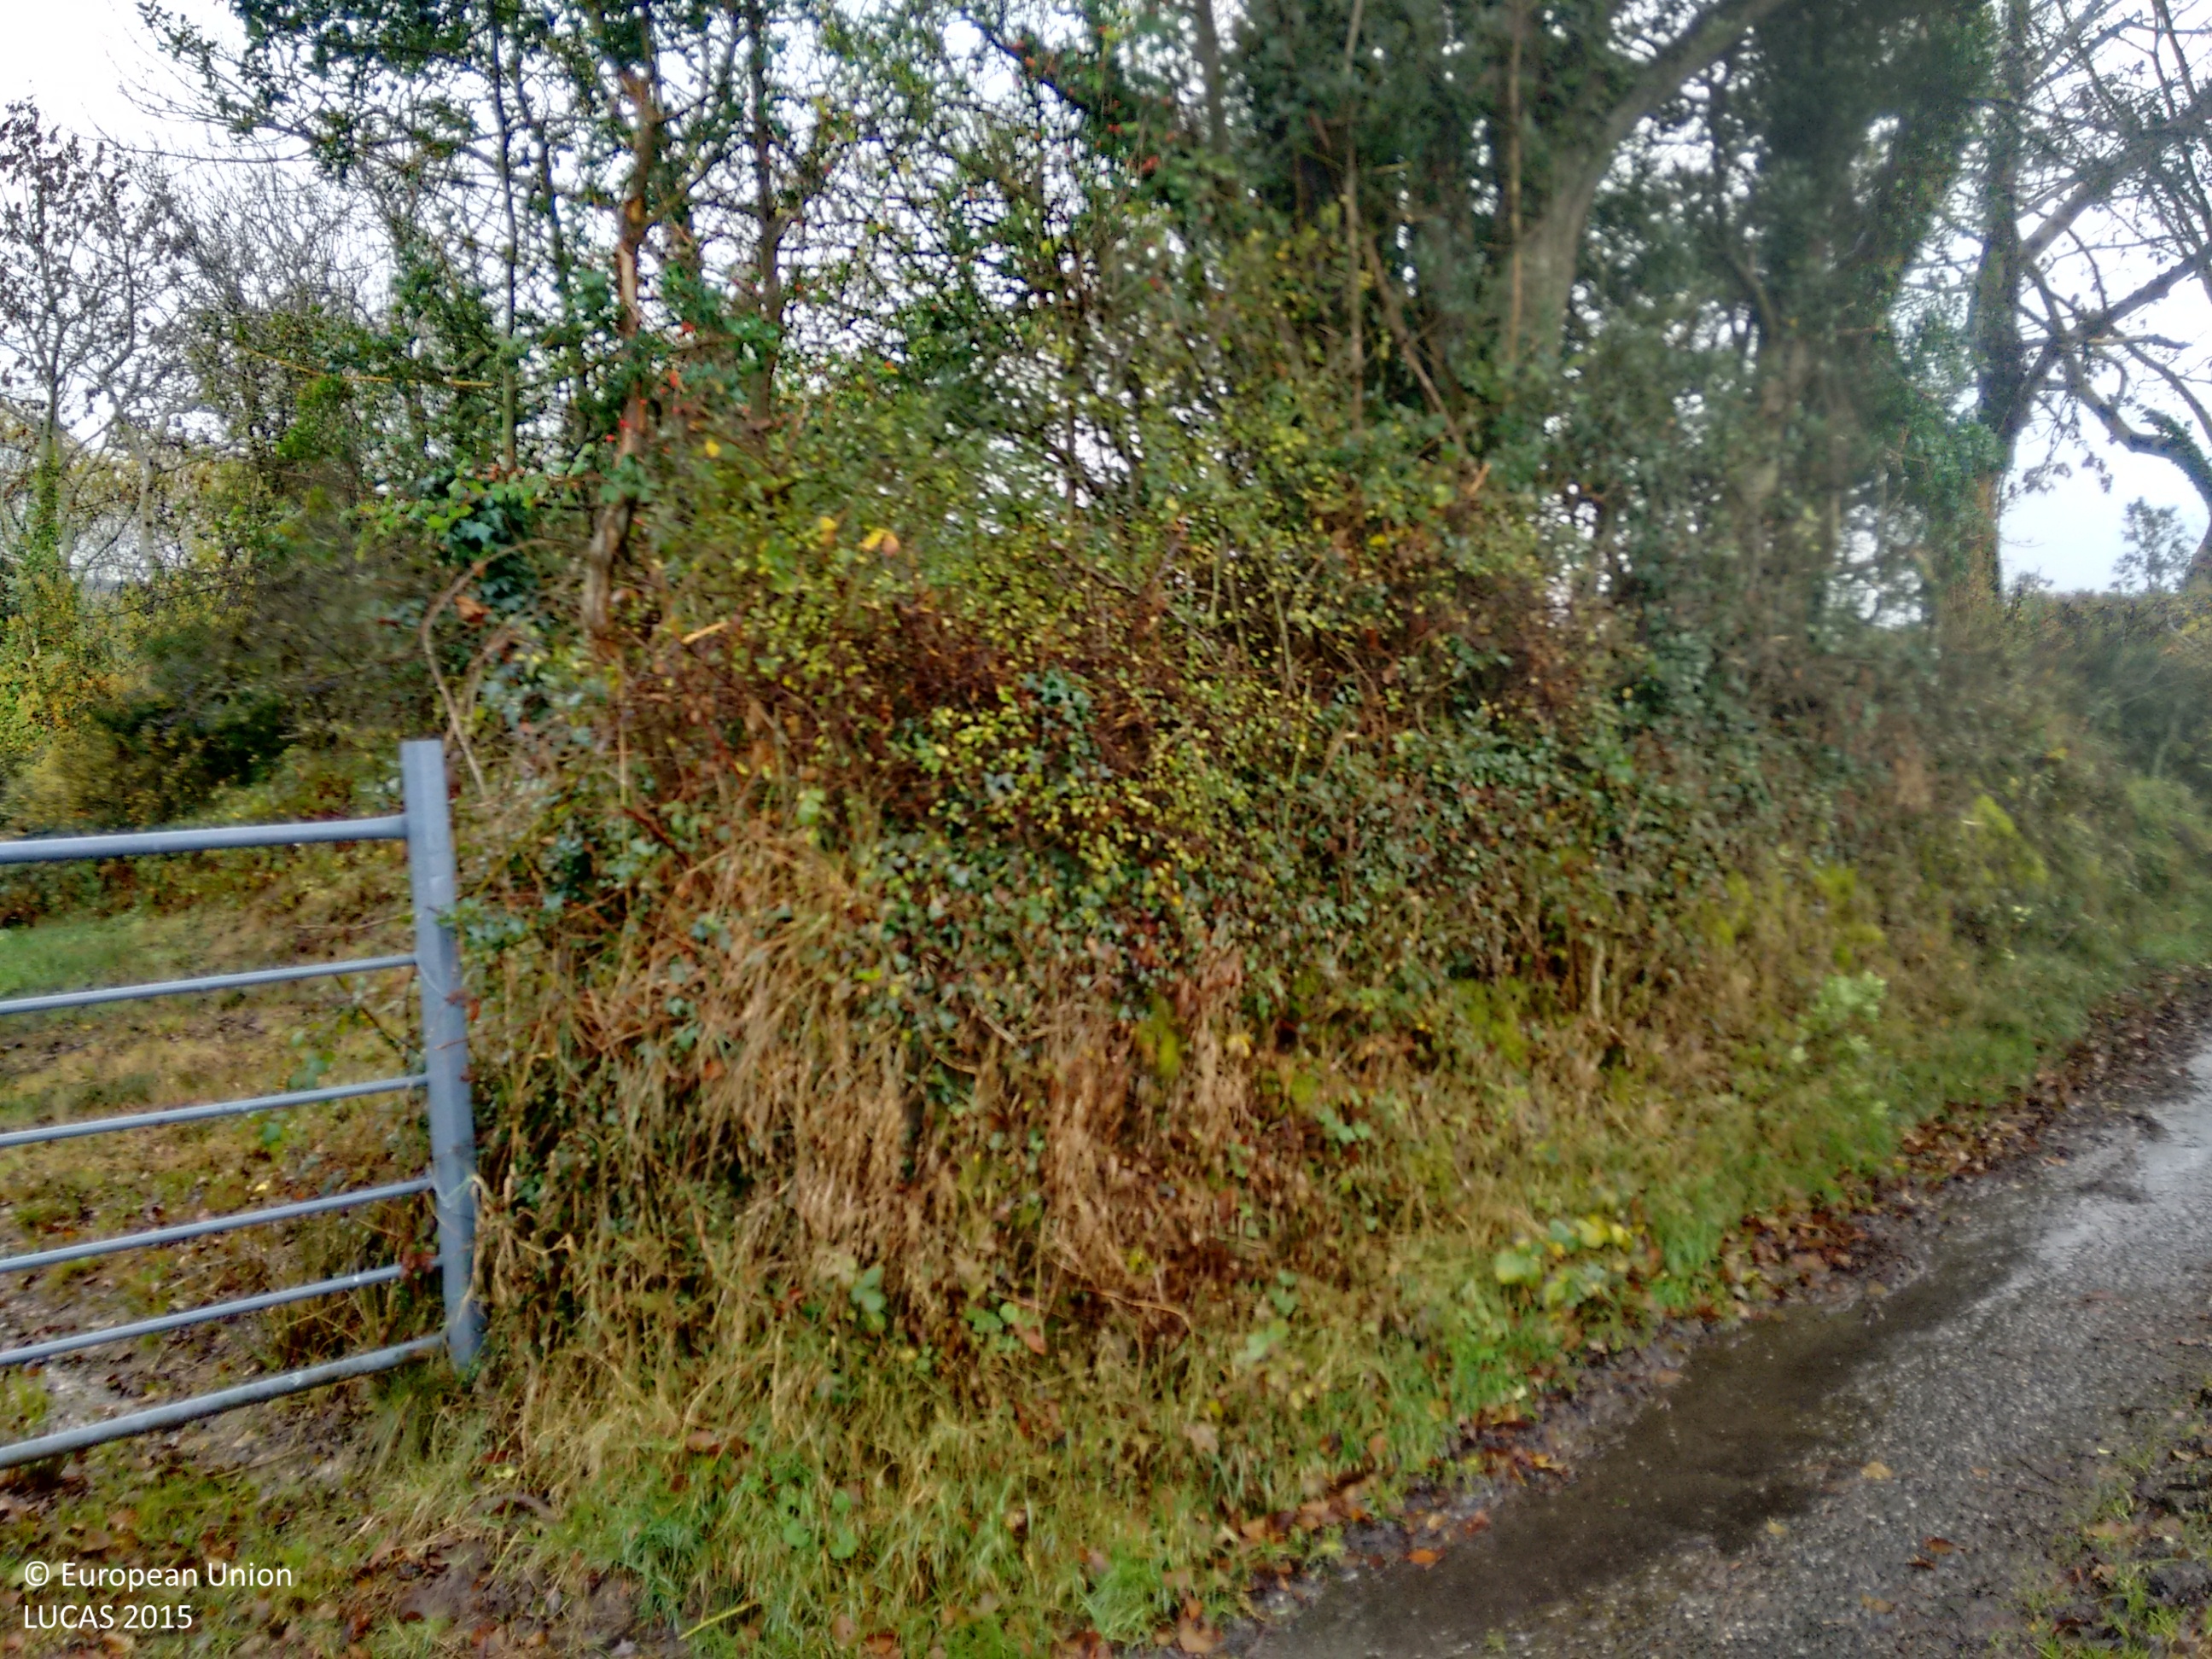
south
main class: Grassland
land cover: Grassland without tree/shrub cover
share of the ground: > 75 %
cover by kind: herbaceous plants 90 %, shrubs 5 %, consolidated bare surface 5 %
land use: Agriculture (excluding fallow land and kitchen gardens)
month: November
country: IE
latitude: 53.1292
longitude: -7.4794
